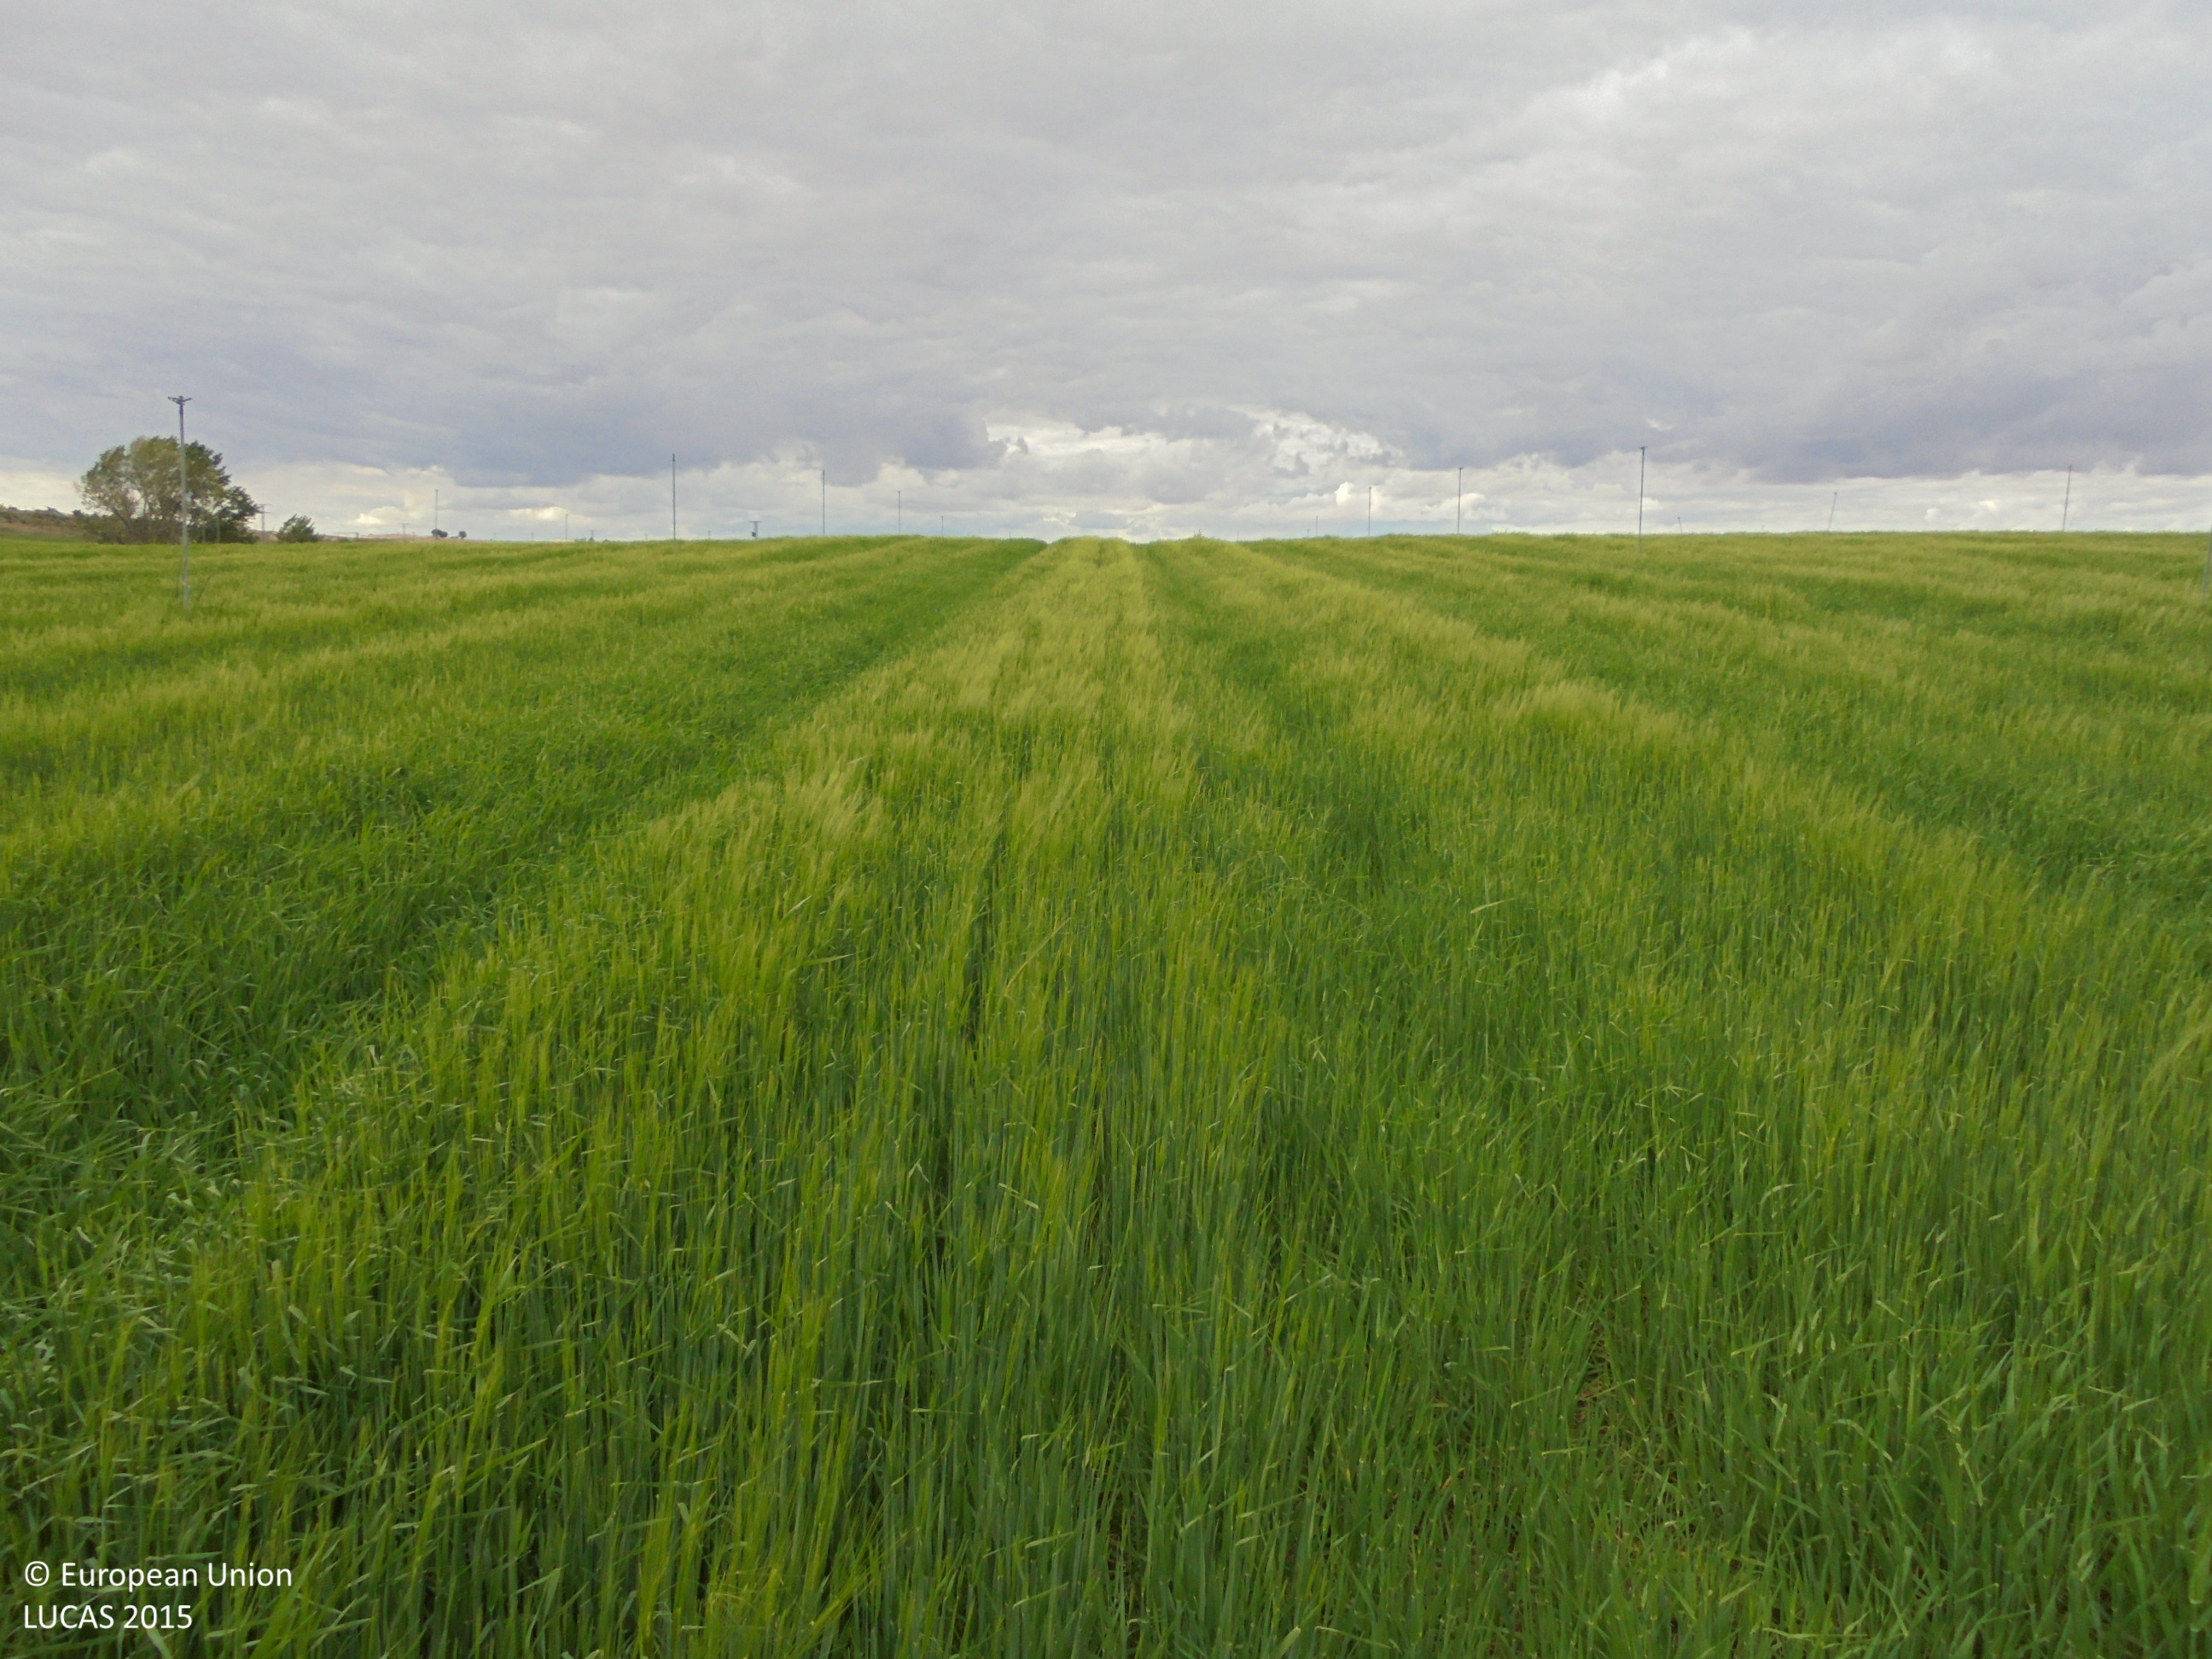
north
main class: Cropland
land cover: Barley
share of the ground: > 75 %
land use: Agriculture (excluding fallow land and kitchen gardens)
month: April
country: ES
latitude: 39.1693
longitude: -1.7964
